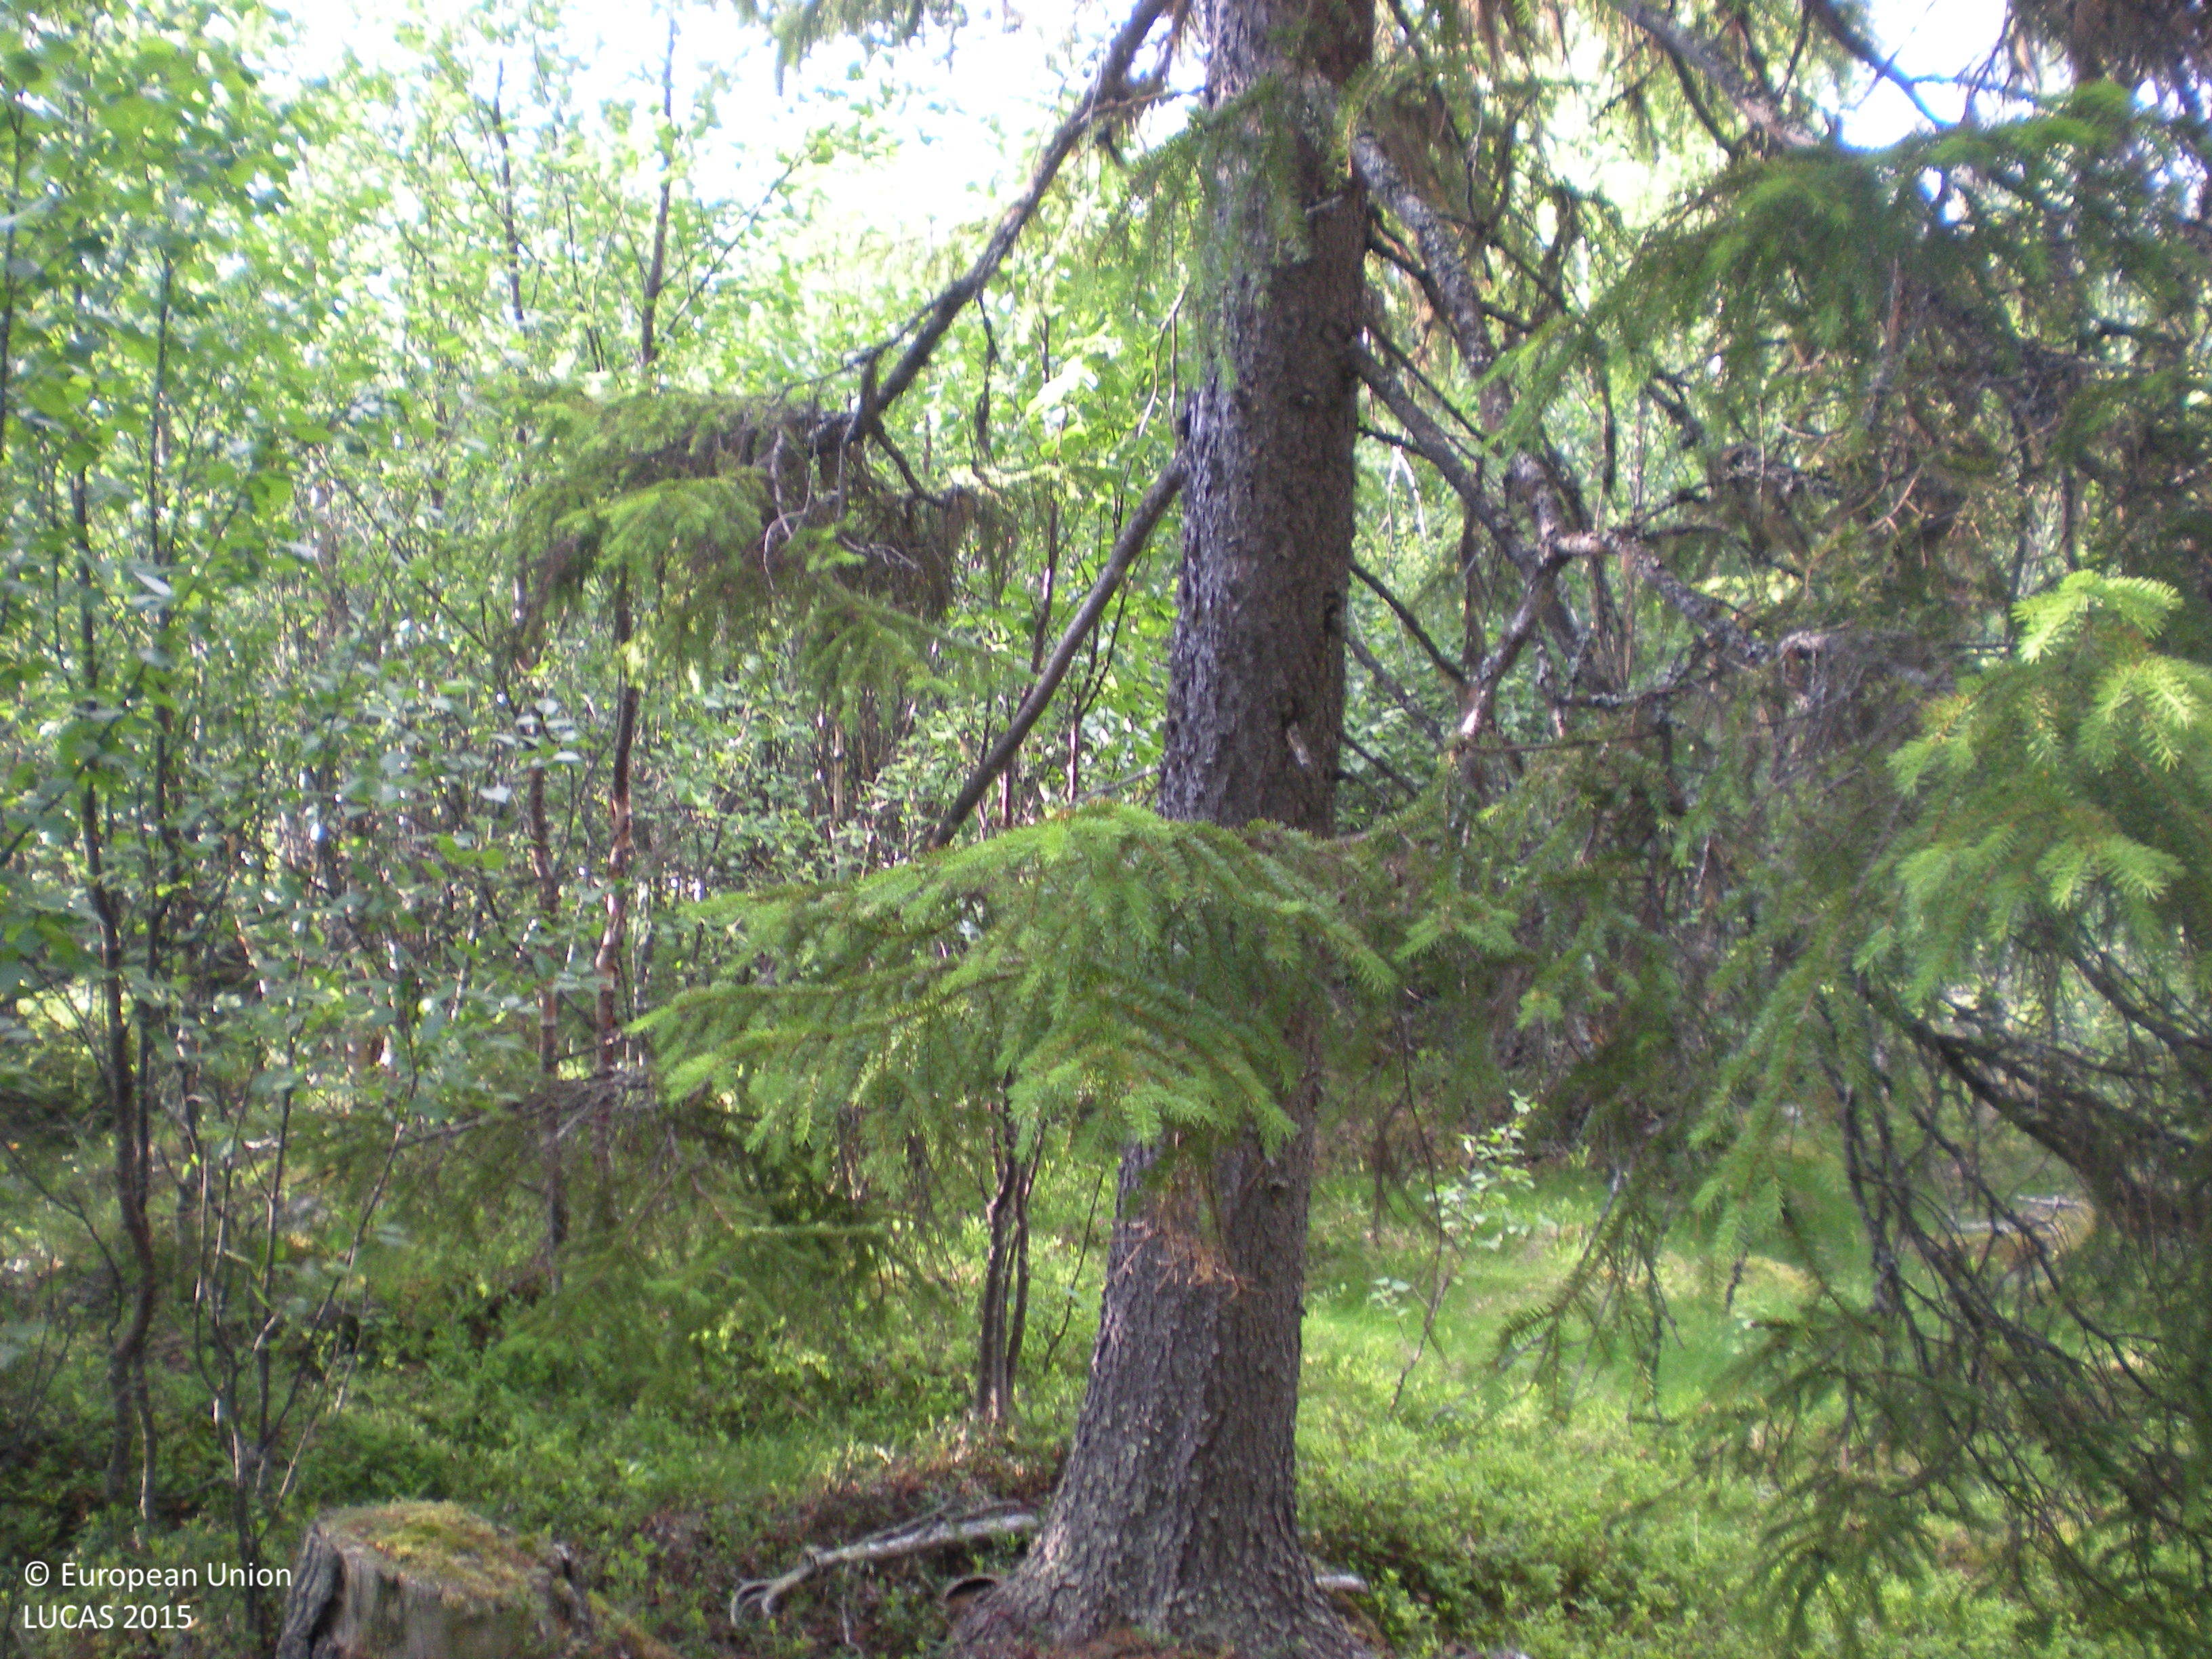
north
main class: Woodland
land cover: Spruce dominated mixed woodland
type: boreal forest
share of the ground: > 75 %
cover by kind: coniferous forest trees 60 %, broadleaved forest trees 20 %, shrubs 10 %, herbaceous plants 5 %, lichens and mosses 5 %
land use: Forestry
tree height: > 5 m
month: July
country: SE
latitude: 65.6025
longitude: 17.0543
